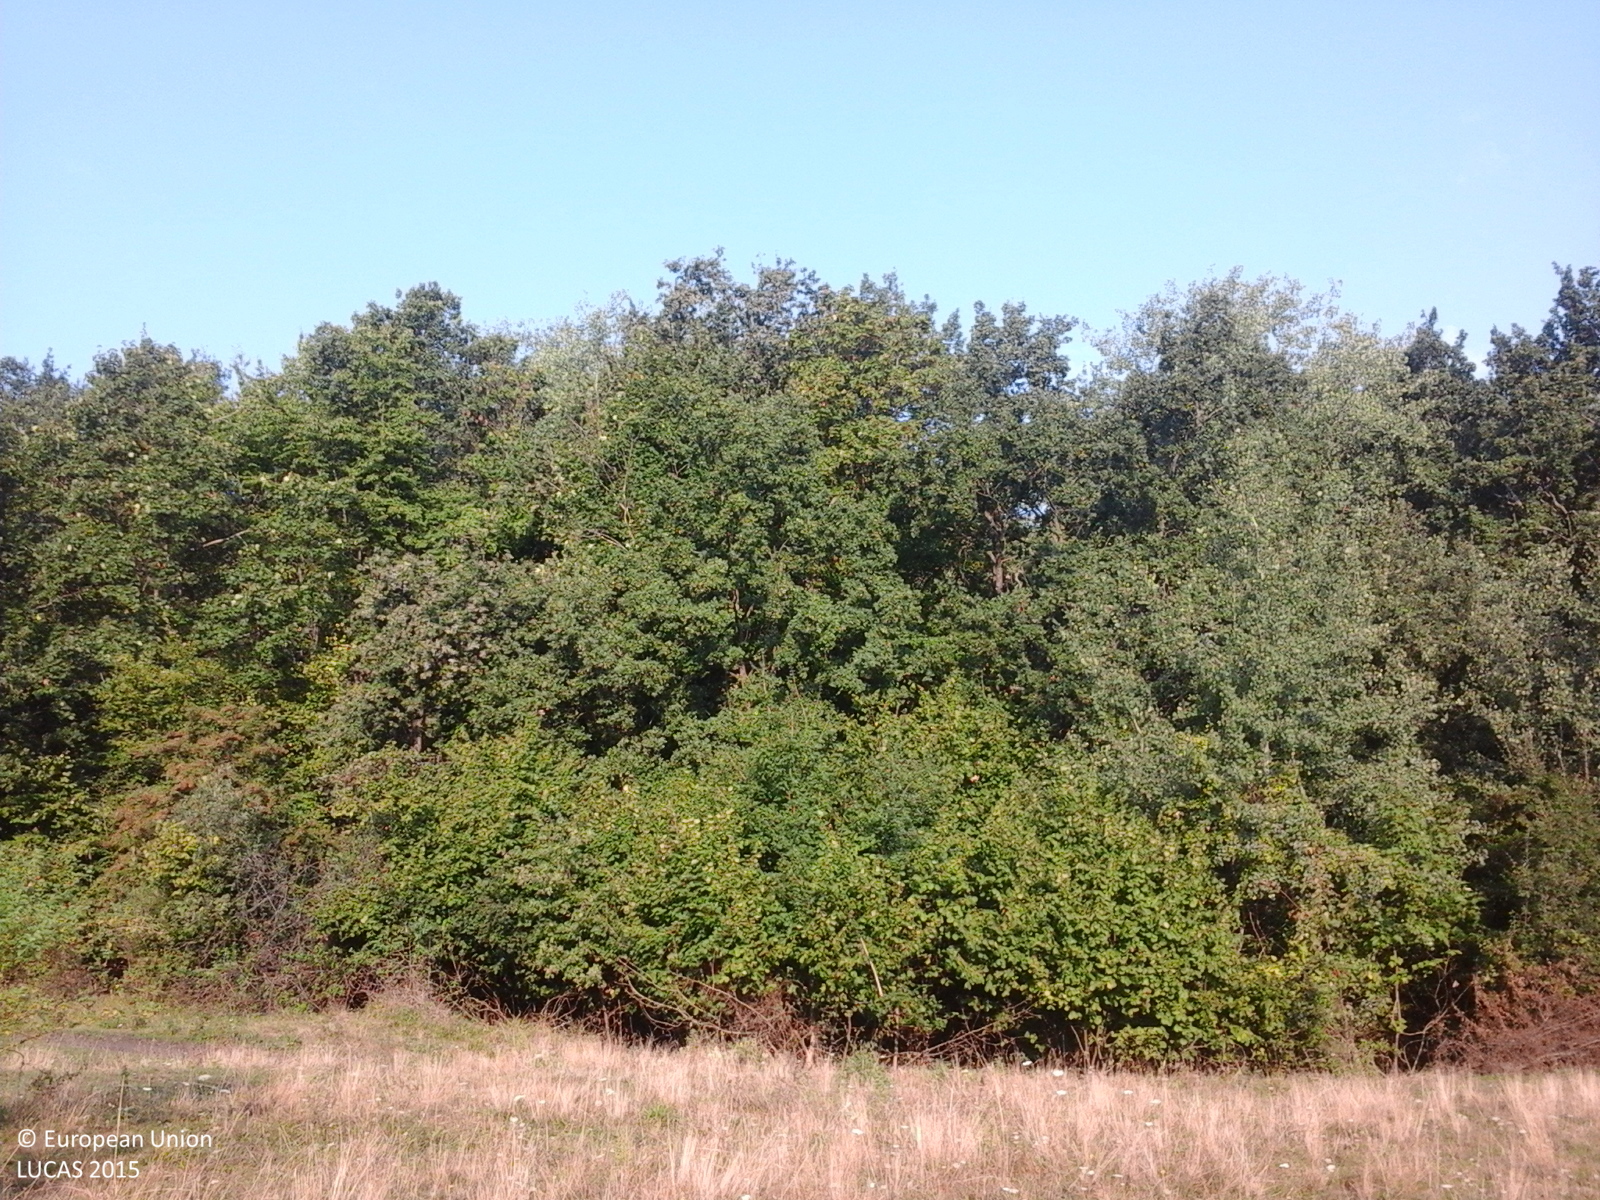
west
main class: Grassland
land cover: Grassland with sparse tree/shrub cover
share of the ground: > 75 %
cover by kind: herbaceous plants 95 %, broadleaved forest trees 5 %
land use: Fallow land
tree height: < 5 m
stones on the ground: < 10 %
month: September
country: RO
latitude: 47.0529
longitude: 24.5322
